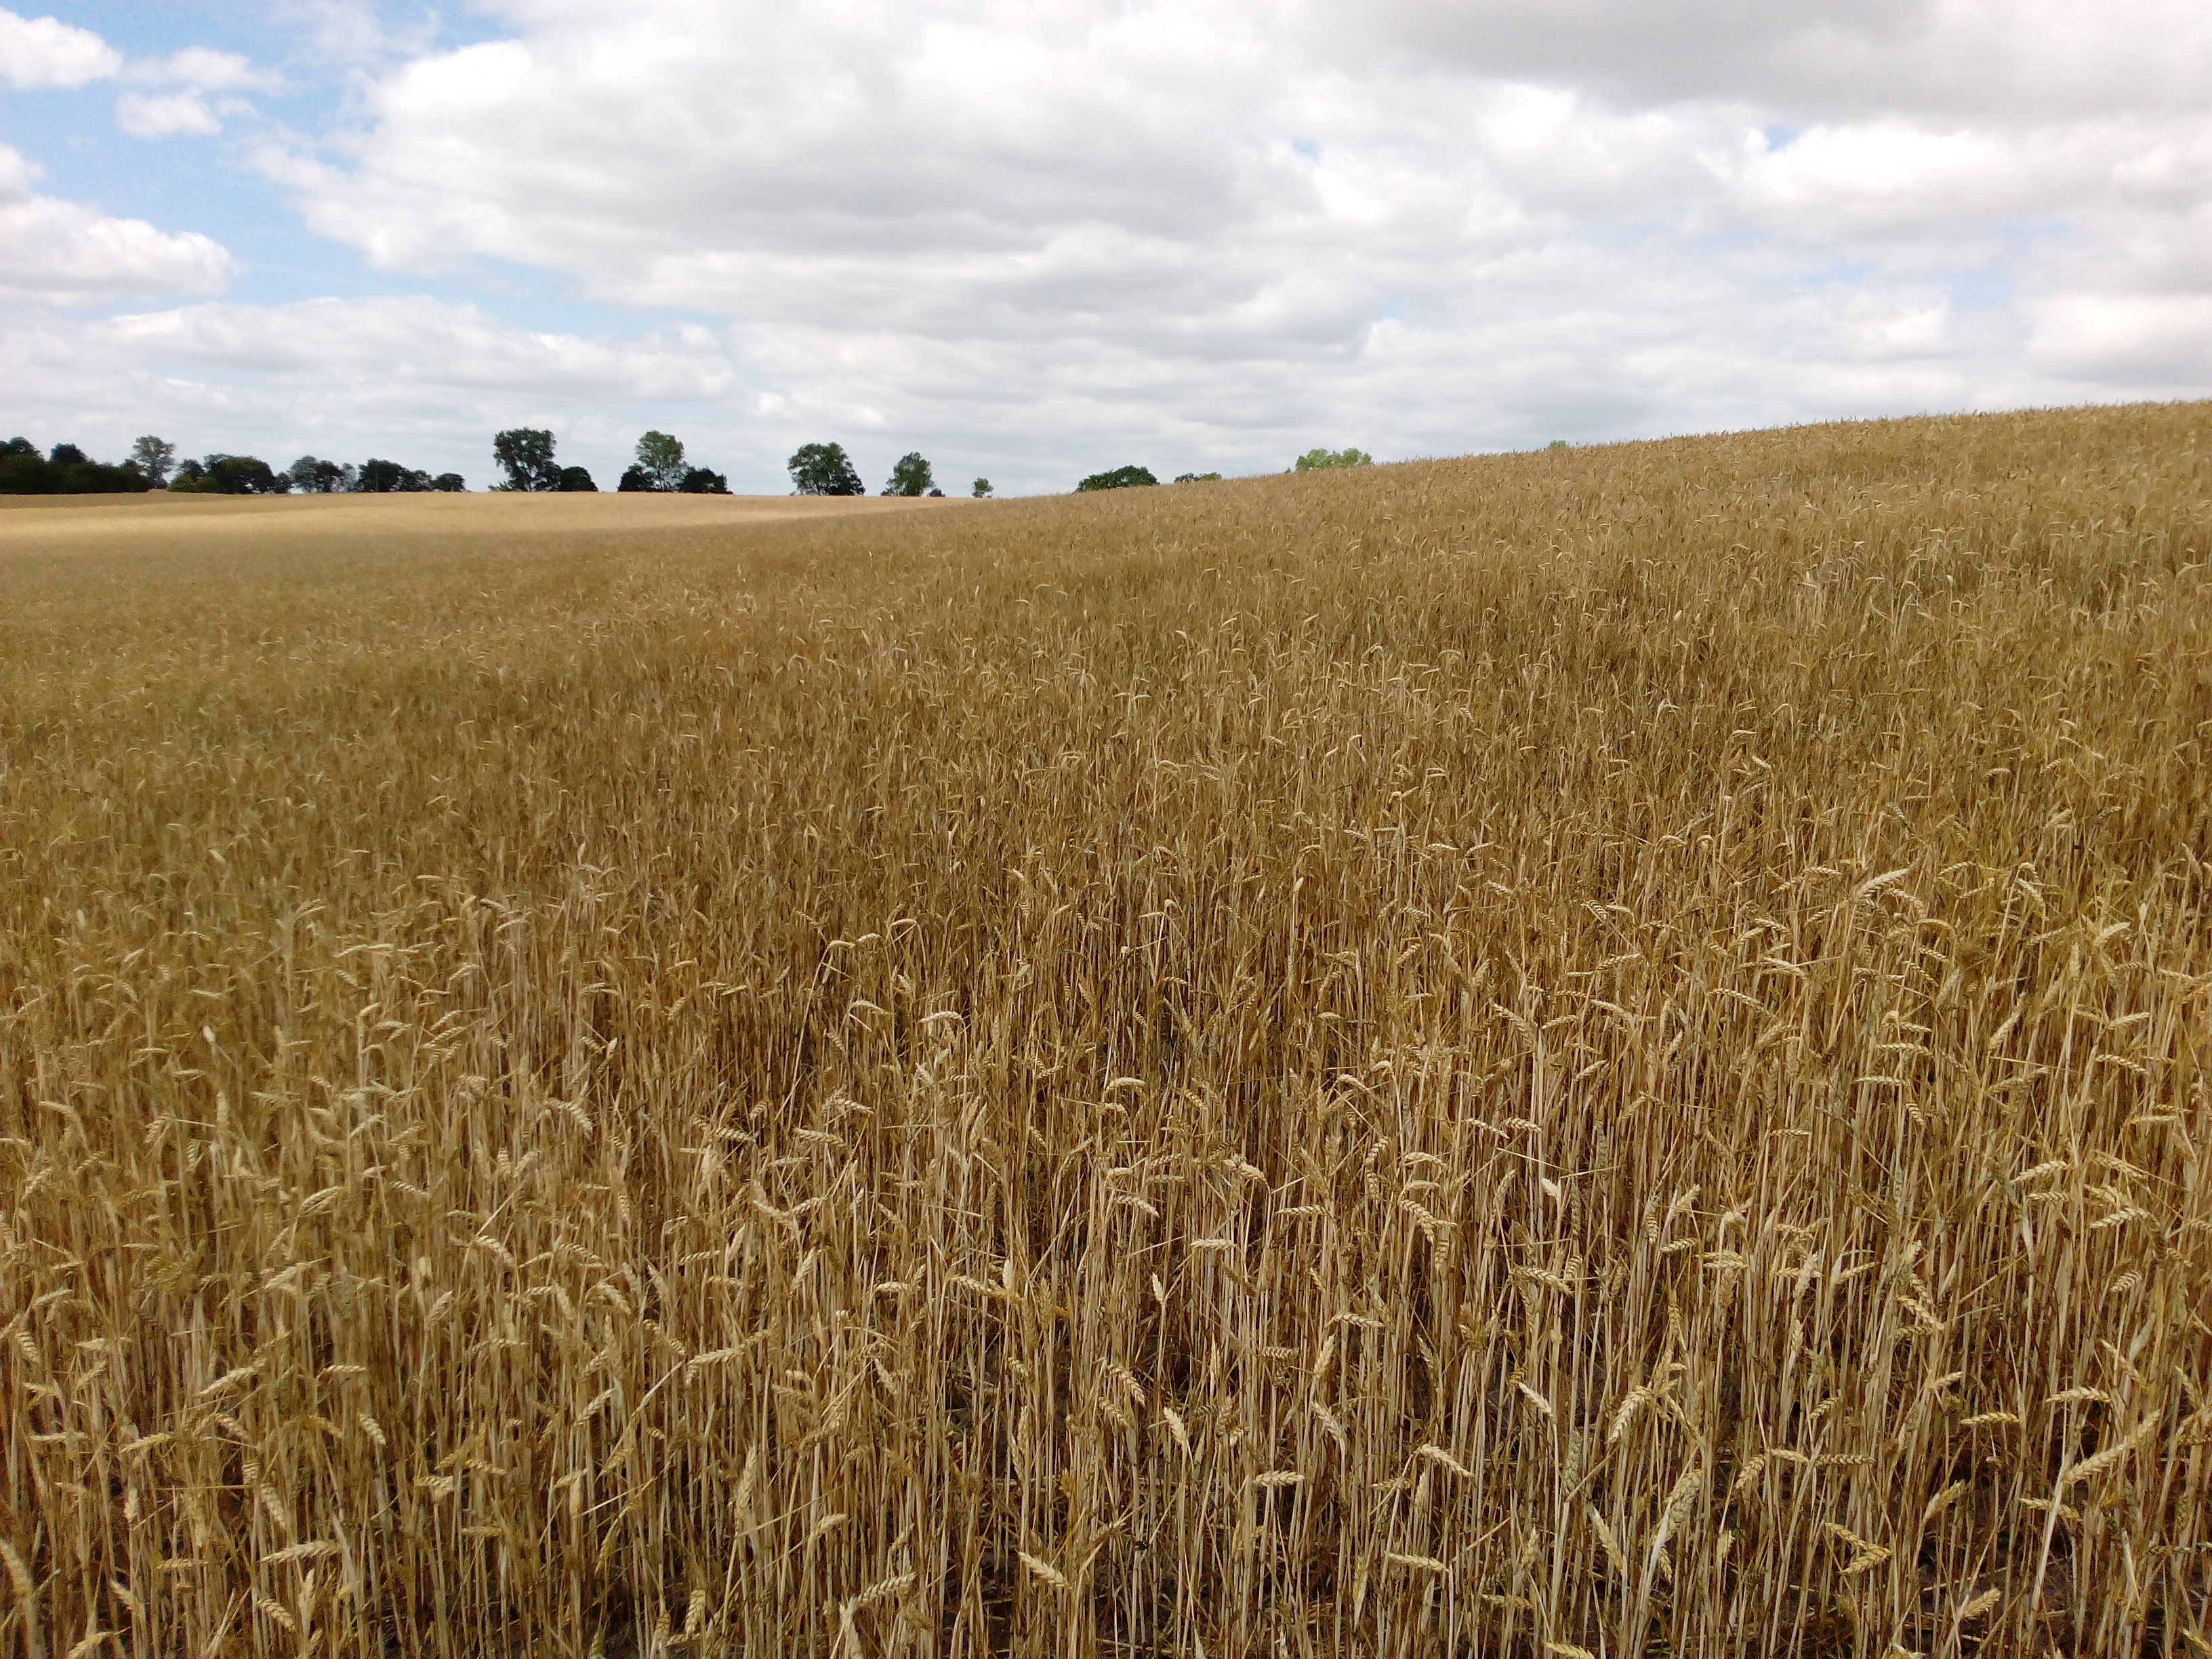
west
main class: Cropland
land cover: Common wheat
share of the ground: > 75 %
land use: Agriculture (excluding fallow land and kitchen gardens)
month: July
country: DE
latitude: 51.1694
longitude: 10.9294
